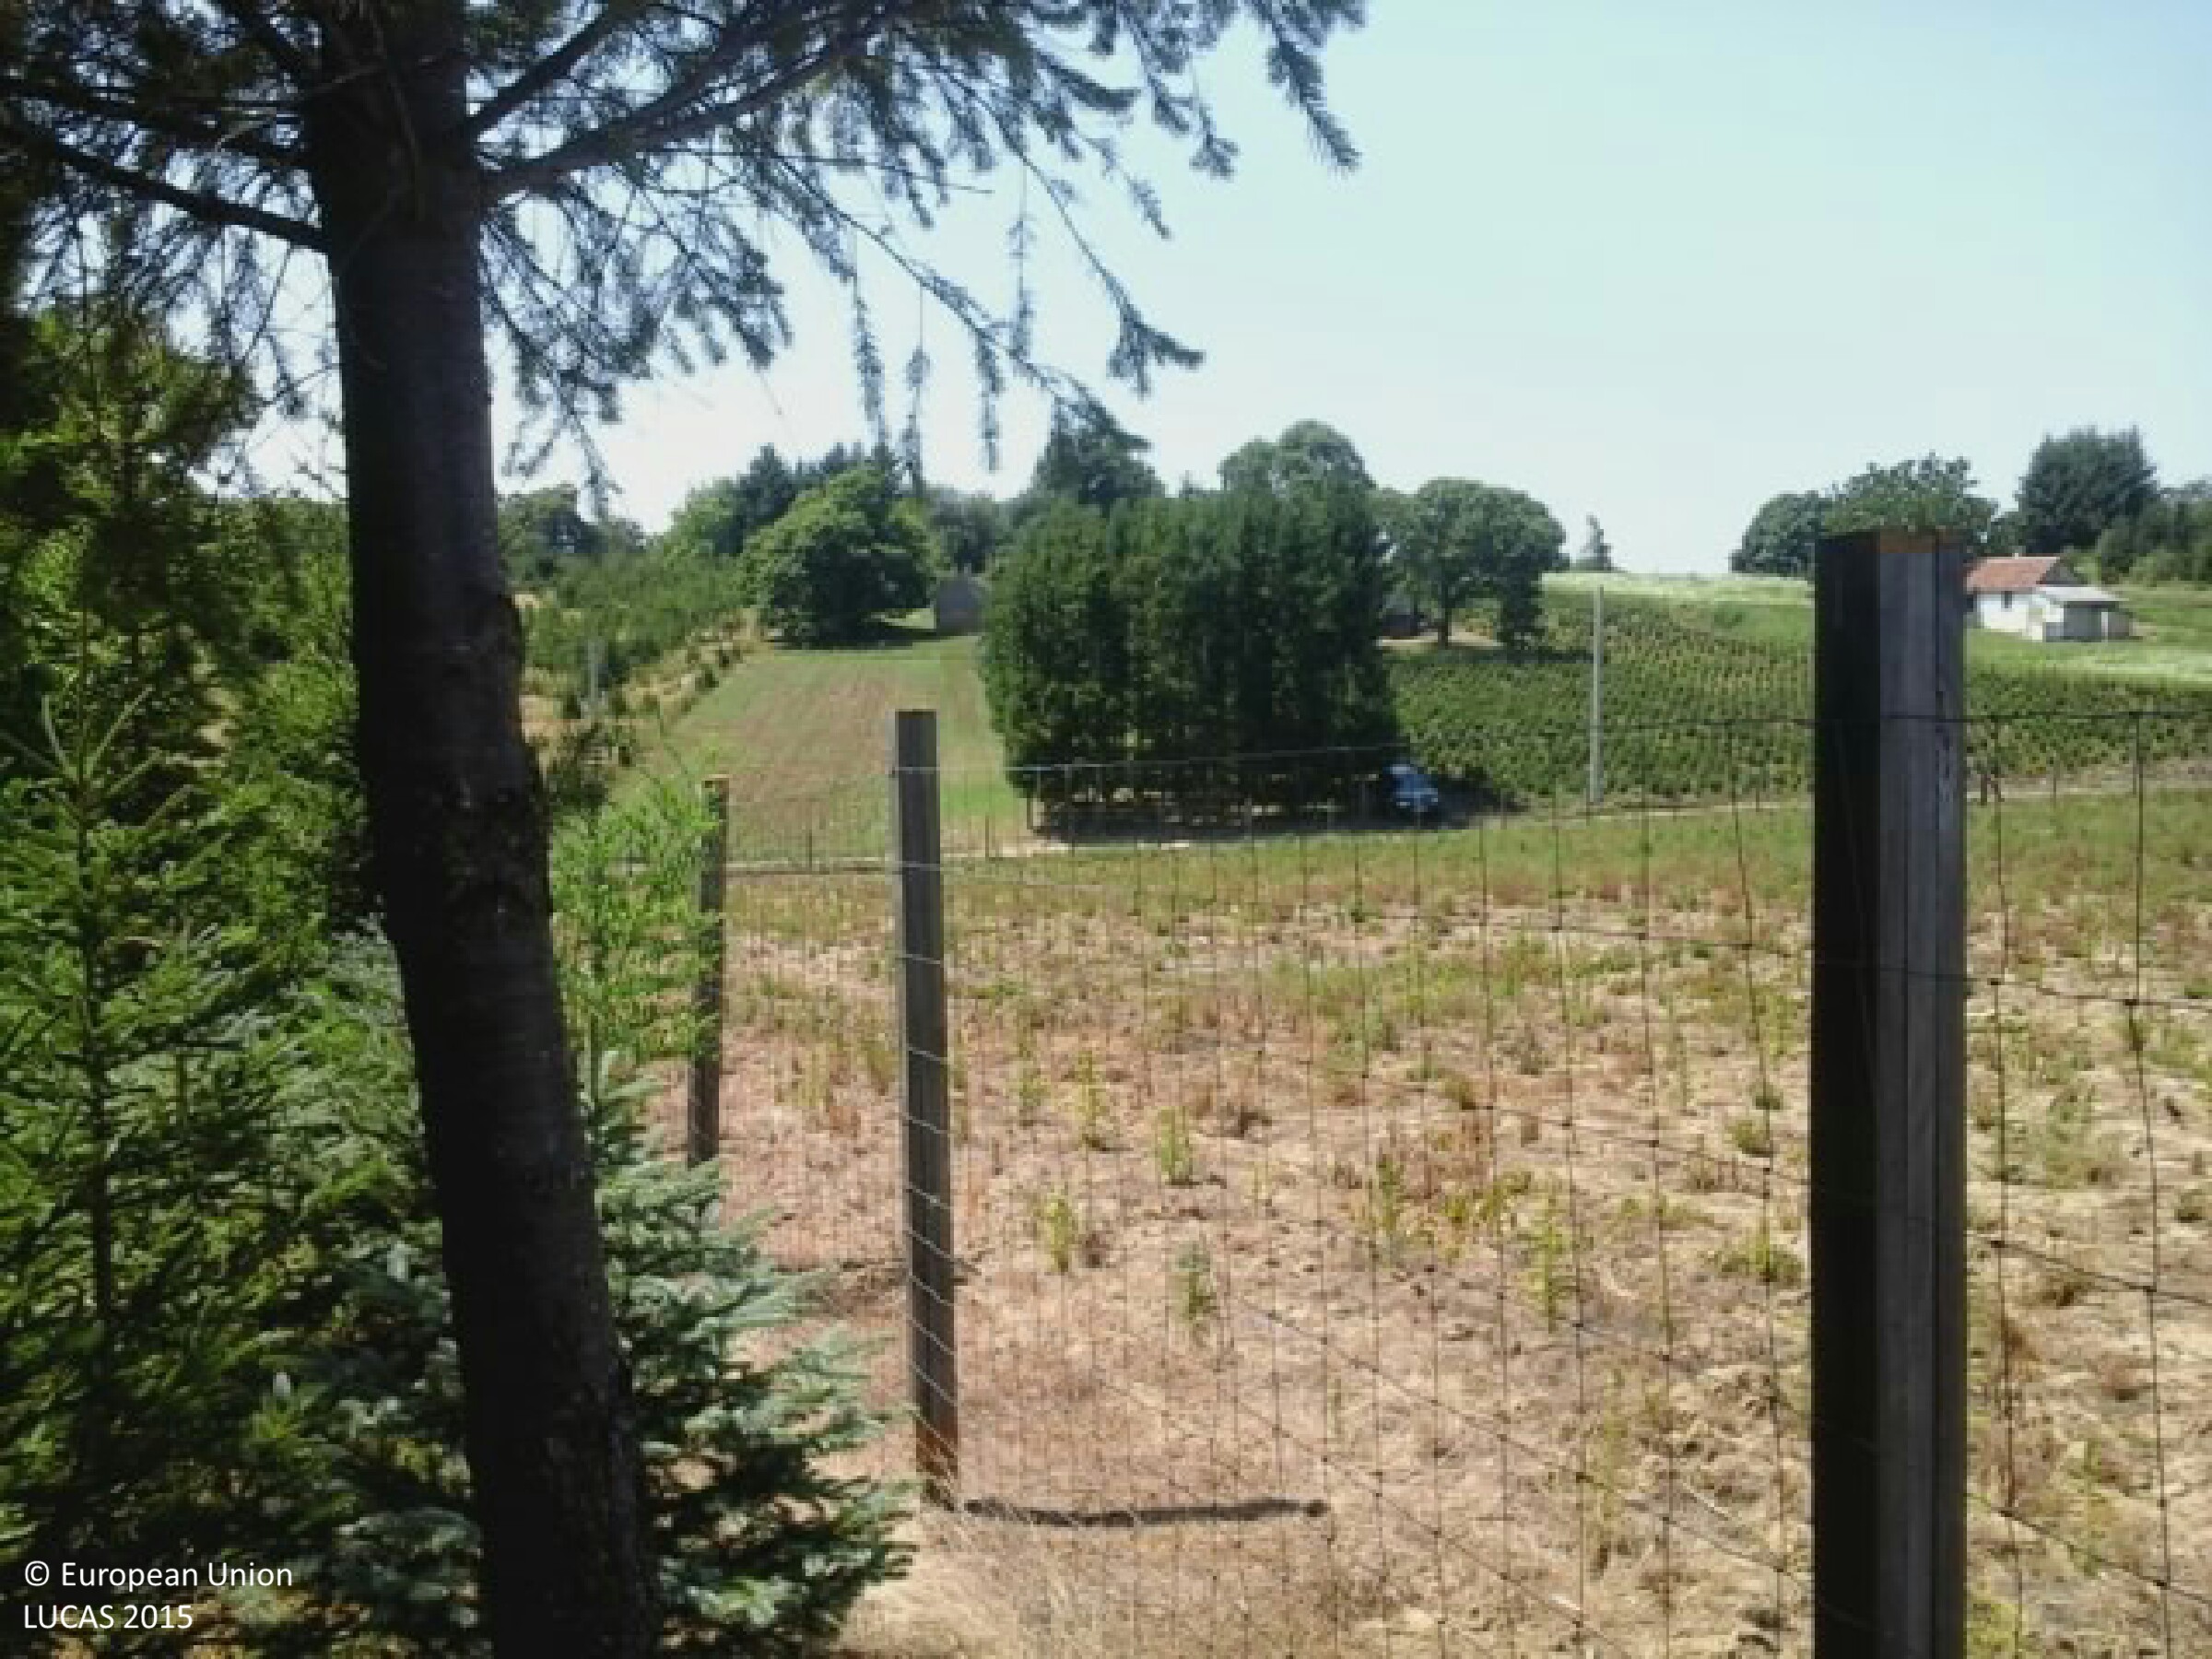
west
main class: Cropland
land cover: Nurseries
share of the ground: 25 - 50 %
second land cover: Spontaneously vegetated surfaces
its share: 50 - 75 %
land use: Forestry
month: July
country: HU
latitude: 46.2795
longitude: 17.0754
